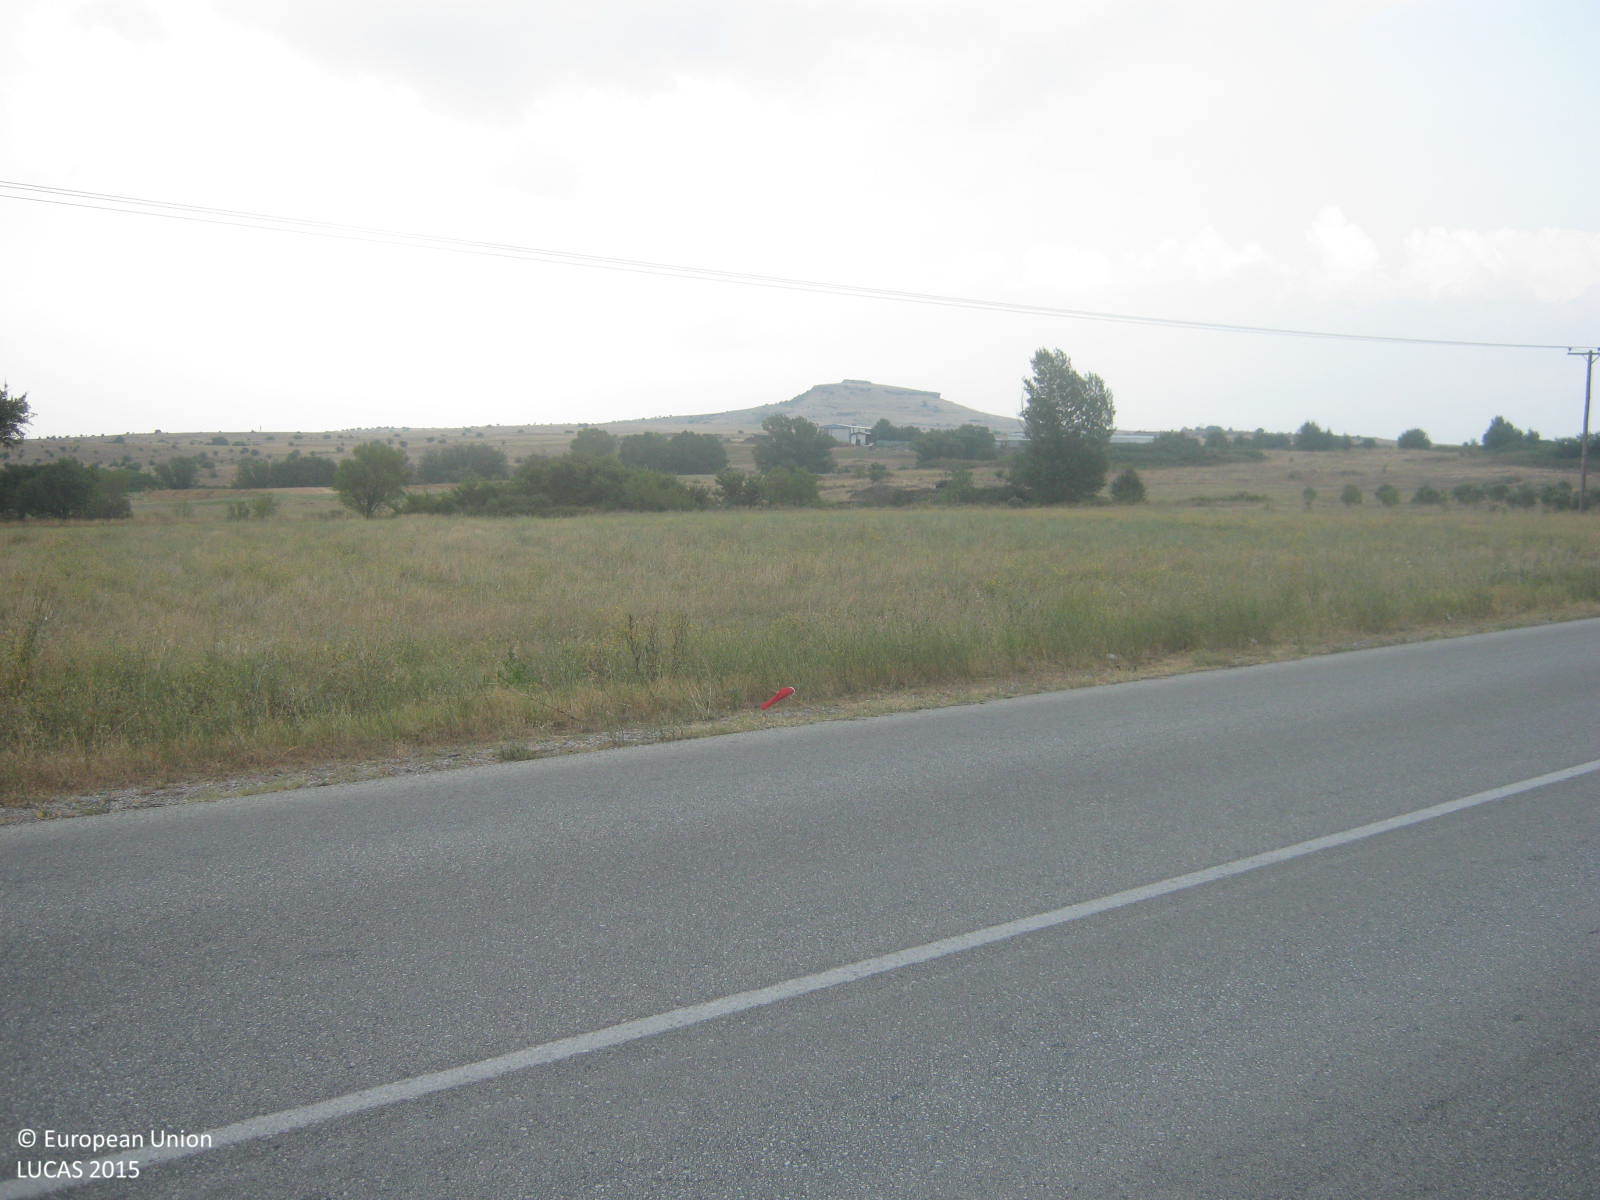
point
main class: Grassland
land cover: Spontaneously vegetated surfaces
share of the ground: > 75 %
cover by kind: herbaceous plants 95 %, shrubs 5 %
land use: Fallow land
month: August
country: GR
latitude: 41.0143
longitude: 22.6723
